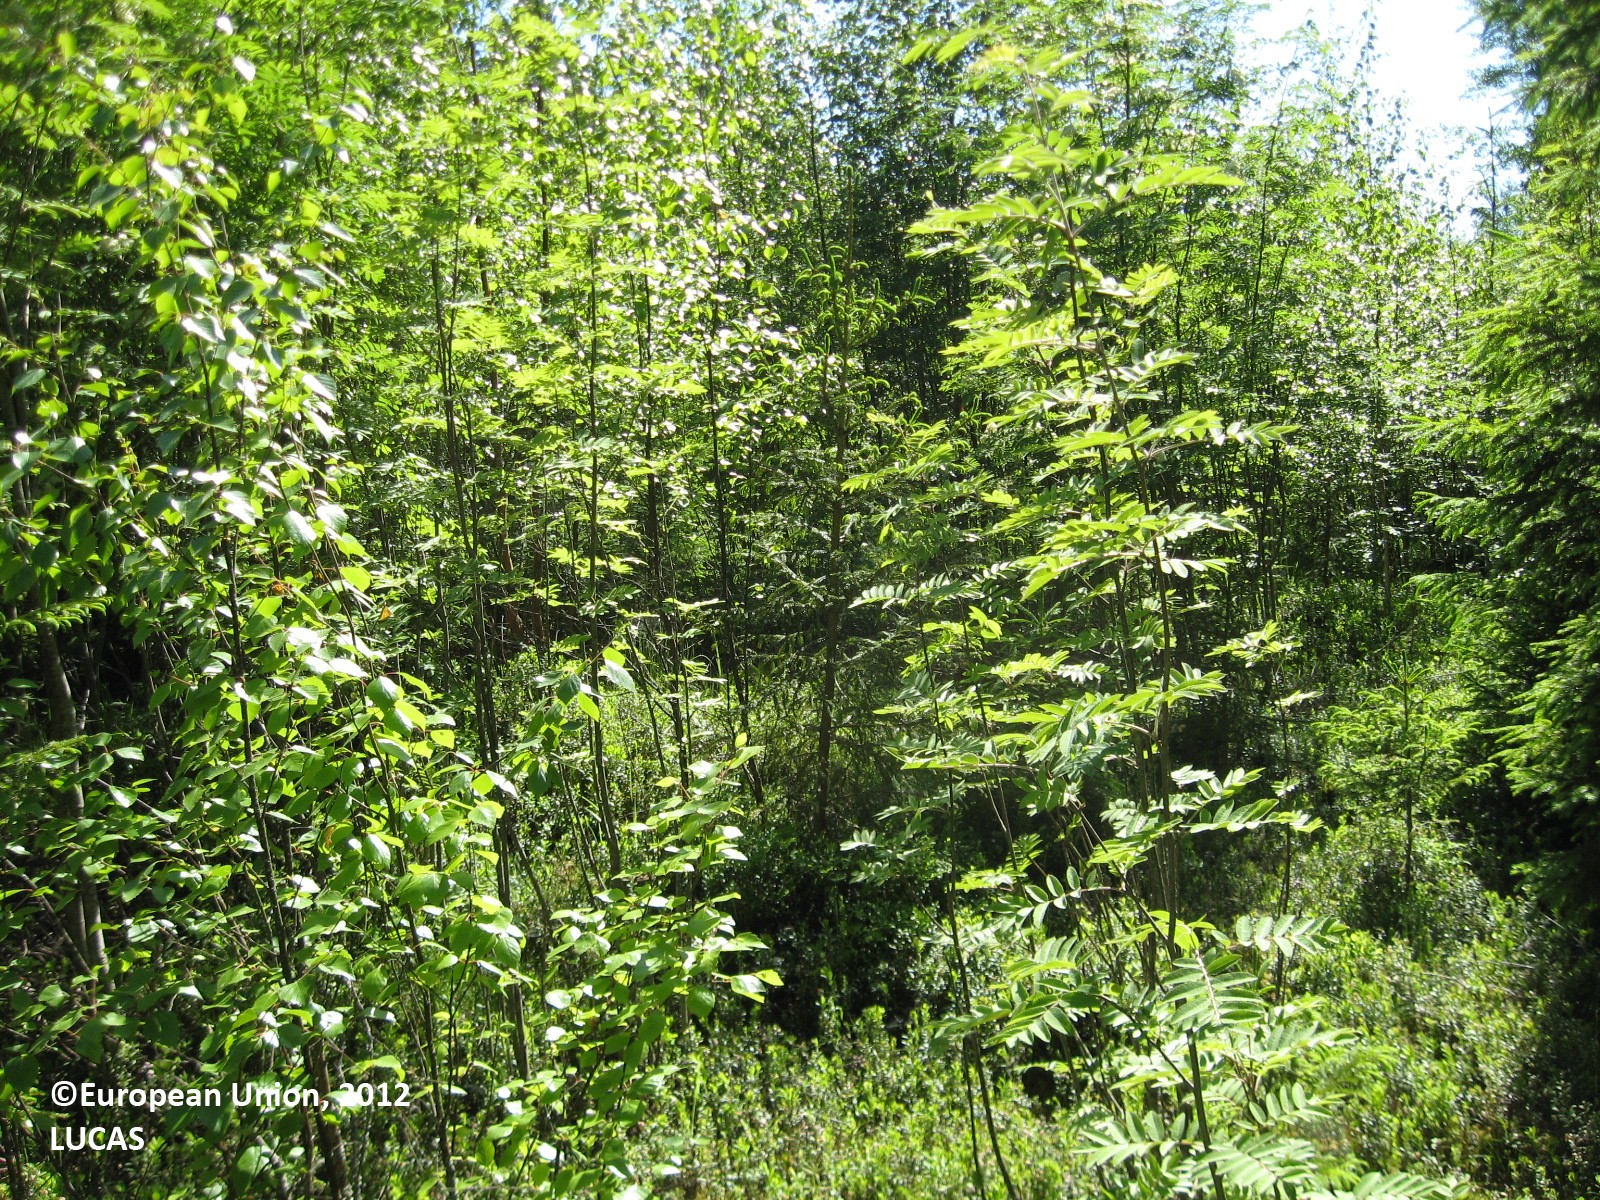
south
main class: Woodland
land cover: Spruce dominated mixed woodland
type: boreal forest
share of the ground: > 75 %
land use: Forestry
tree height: > 5 m
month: June
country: FI
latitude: 62.9913
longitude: 21.7468
